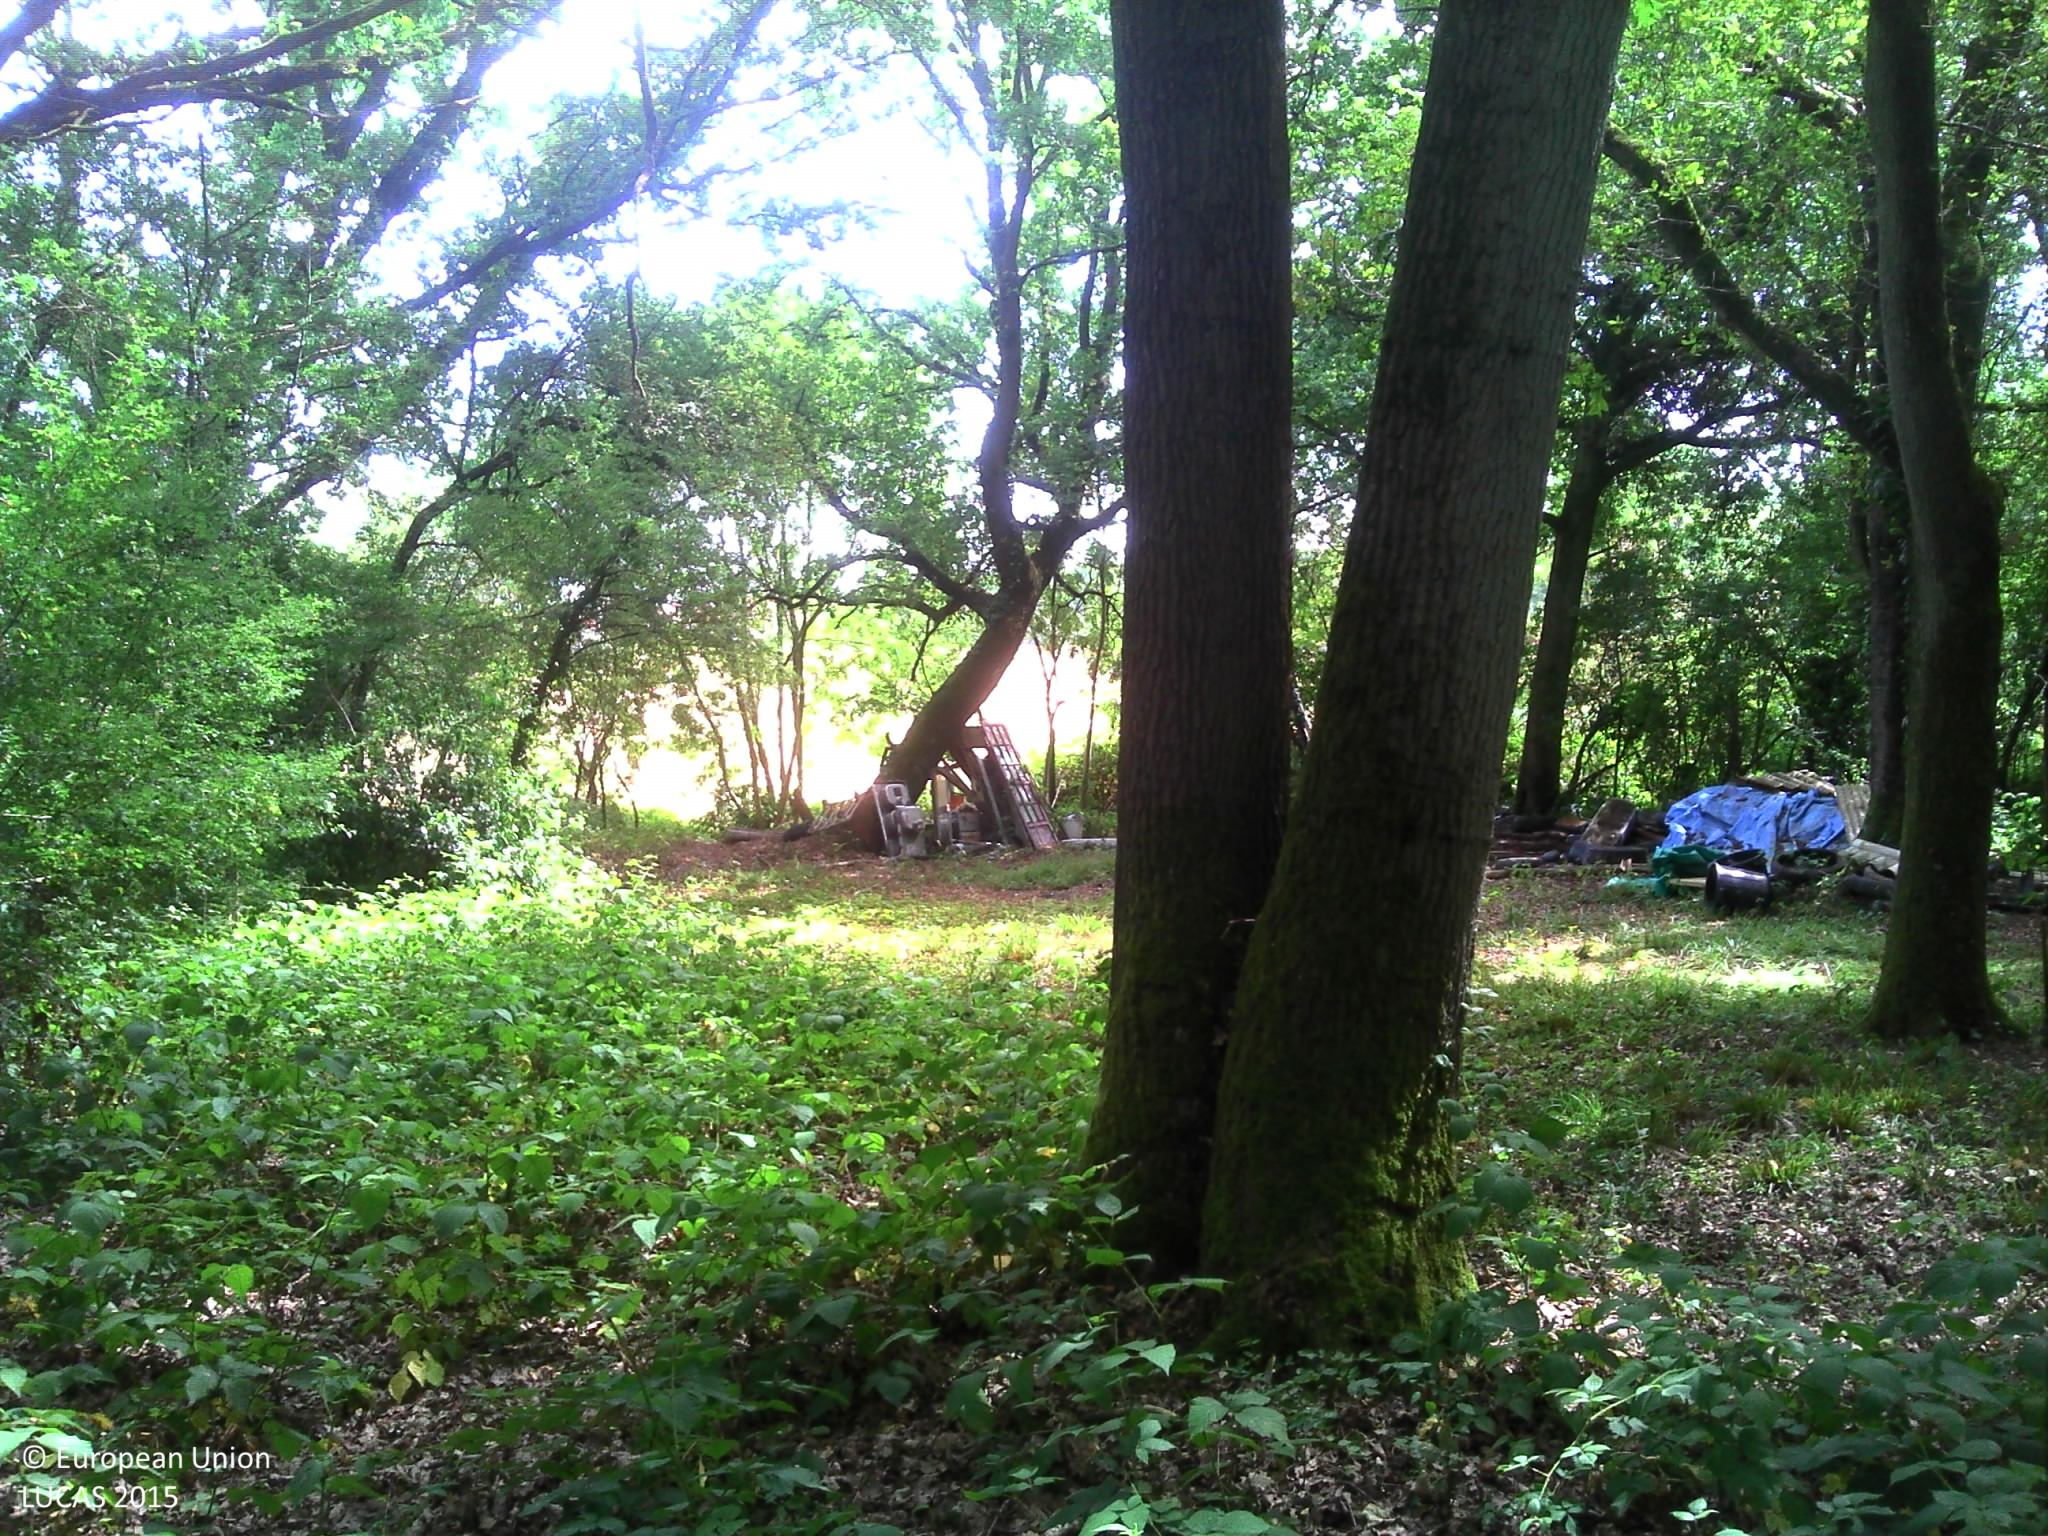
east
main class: Woodland
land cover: Broadleaved woodland
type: beech forest
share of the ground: > 75 %
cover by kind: broadleaved forest trees 40 %, herbaceous plants 20 %, lichens and mosses 20 %, unconsolidated bare surface 10 %
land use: Forestry
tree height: > 5 m
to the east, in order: Broadleaved woodland; Spontaneously vegetated surfaces; Common wheat
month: August
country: FR
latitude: 49.0631
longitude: 2.6673
